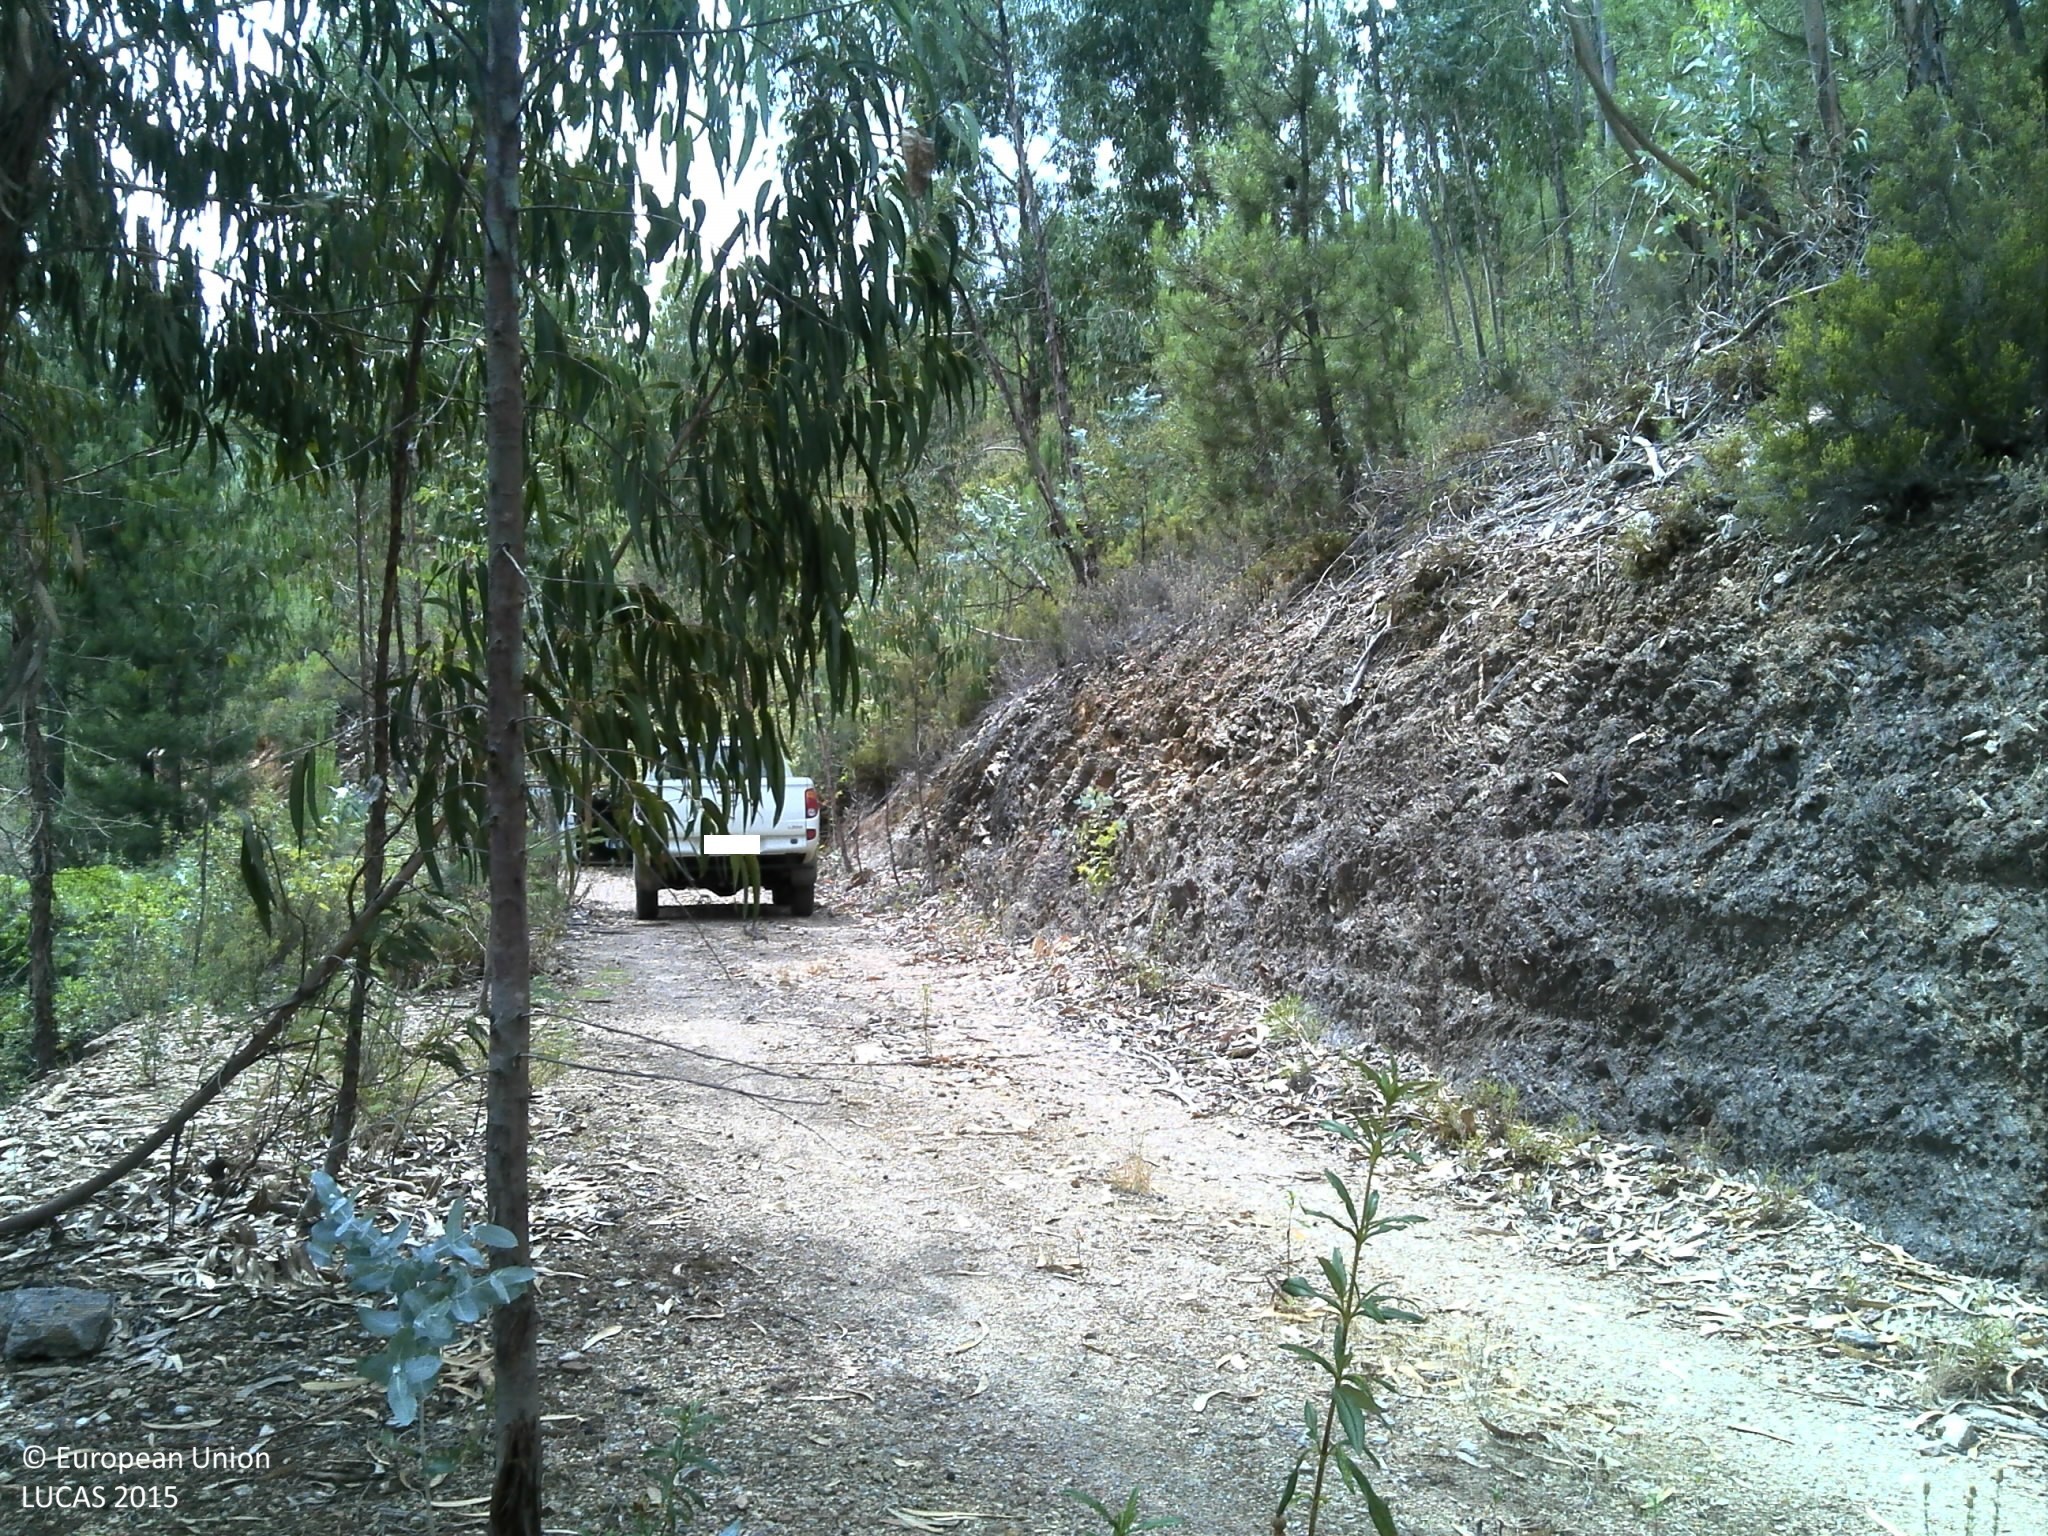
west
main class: Woodland
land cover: Pine dominated mixed woodland
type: coniferous forest of the mediterranean region
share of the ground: 25 - 50 %
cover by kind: shrubs 30 %, unconsolidated bare surface 25 %, consolidated bare surface 20 %, broadleaved forest trees 15 %, coniferous forest trees 10 %
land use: Forestry
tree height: > 5 m
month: July
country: PT
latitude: 39.6153
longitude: -8.0354
